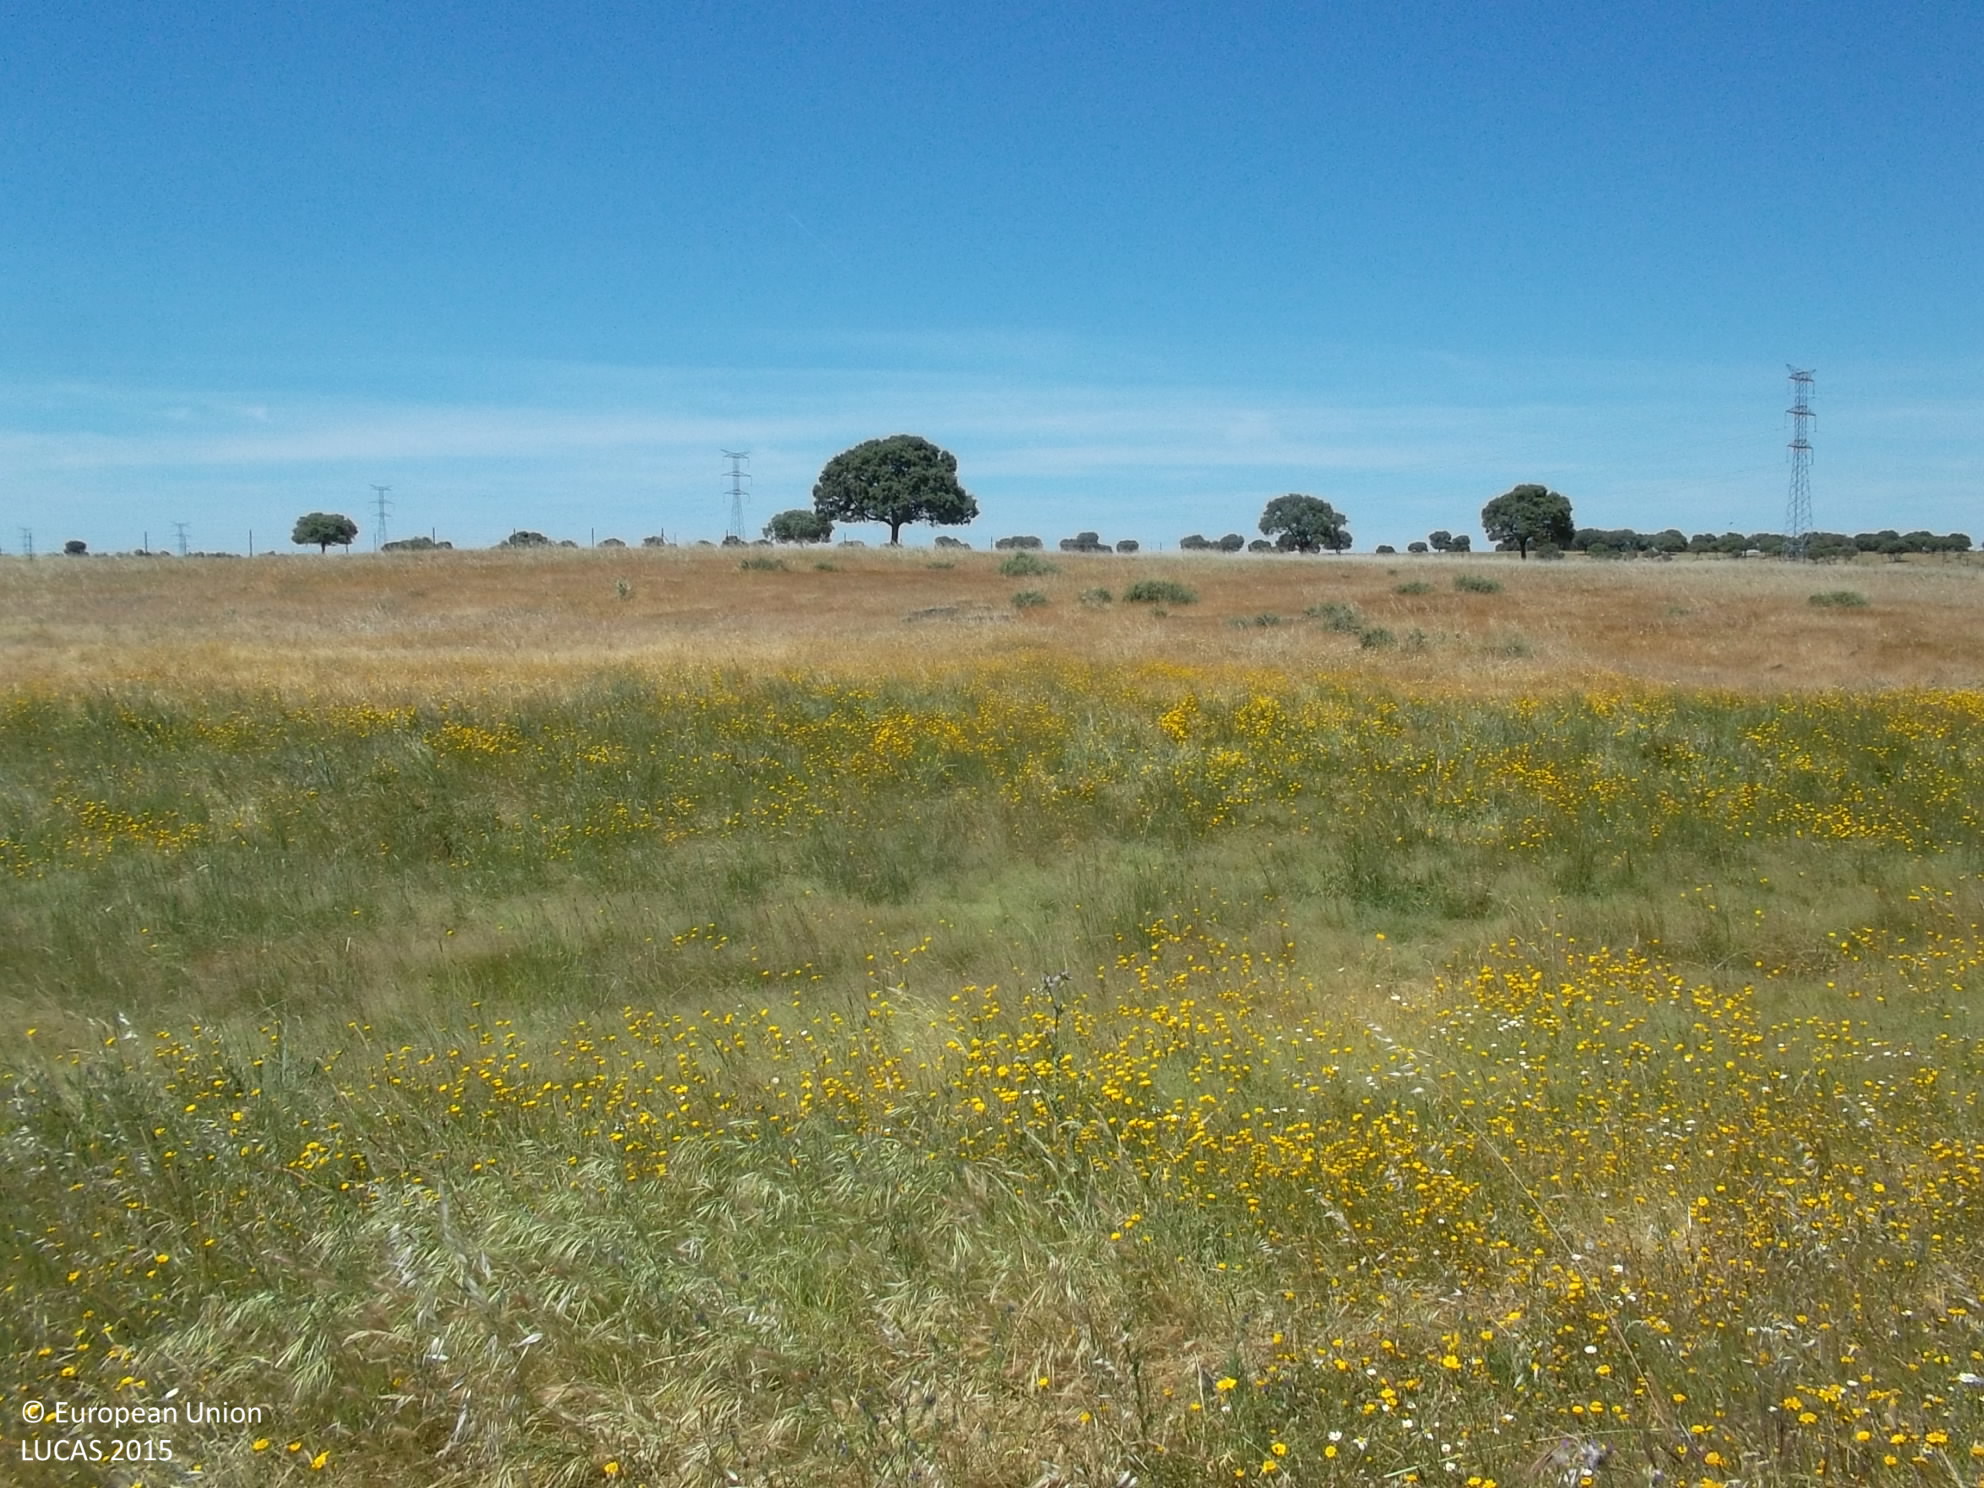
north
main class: Grassland
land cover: Grassland with sparse tree/shrub cover
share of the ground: > 75 %
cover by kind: herbaceous plants 95 %, broadleaved forest trees 5 %
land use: Agriculture (excluding fallow land and kitchen gardens)
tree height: > 5 m
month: May
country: ES
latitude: 38.8621
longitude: -4.4423
